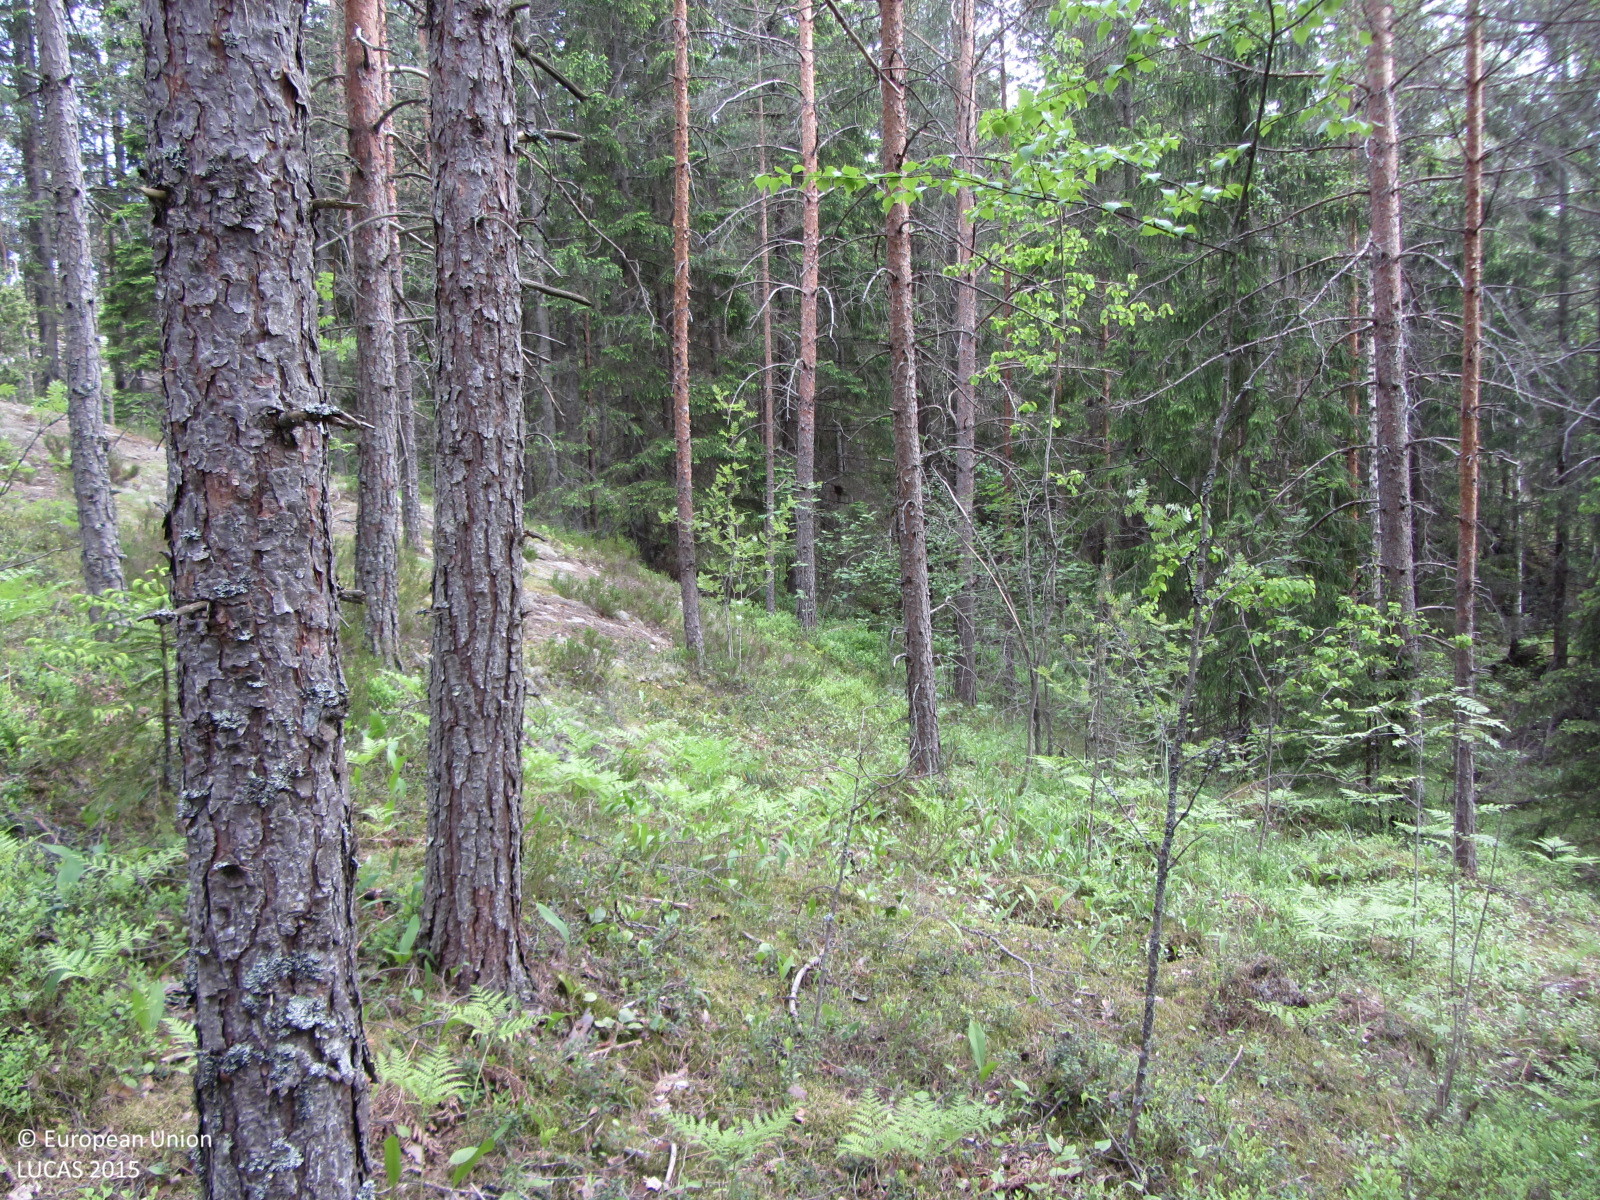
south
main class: Woodland
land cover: Pine dominated mixed woodland
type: boreal forest
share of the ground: > 75 %
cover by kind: coniferous forest trees 55 %, broadleaved forest trees 20 %, herbaceous plants 10 %, lichens and mosses 10 %, shrubs 5 %
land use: Semi-natural and natural areas not in use
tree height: > 5 m
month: June
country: FI
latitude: 60.2960
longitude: 24.6017
